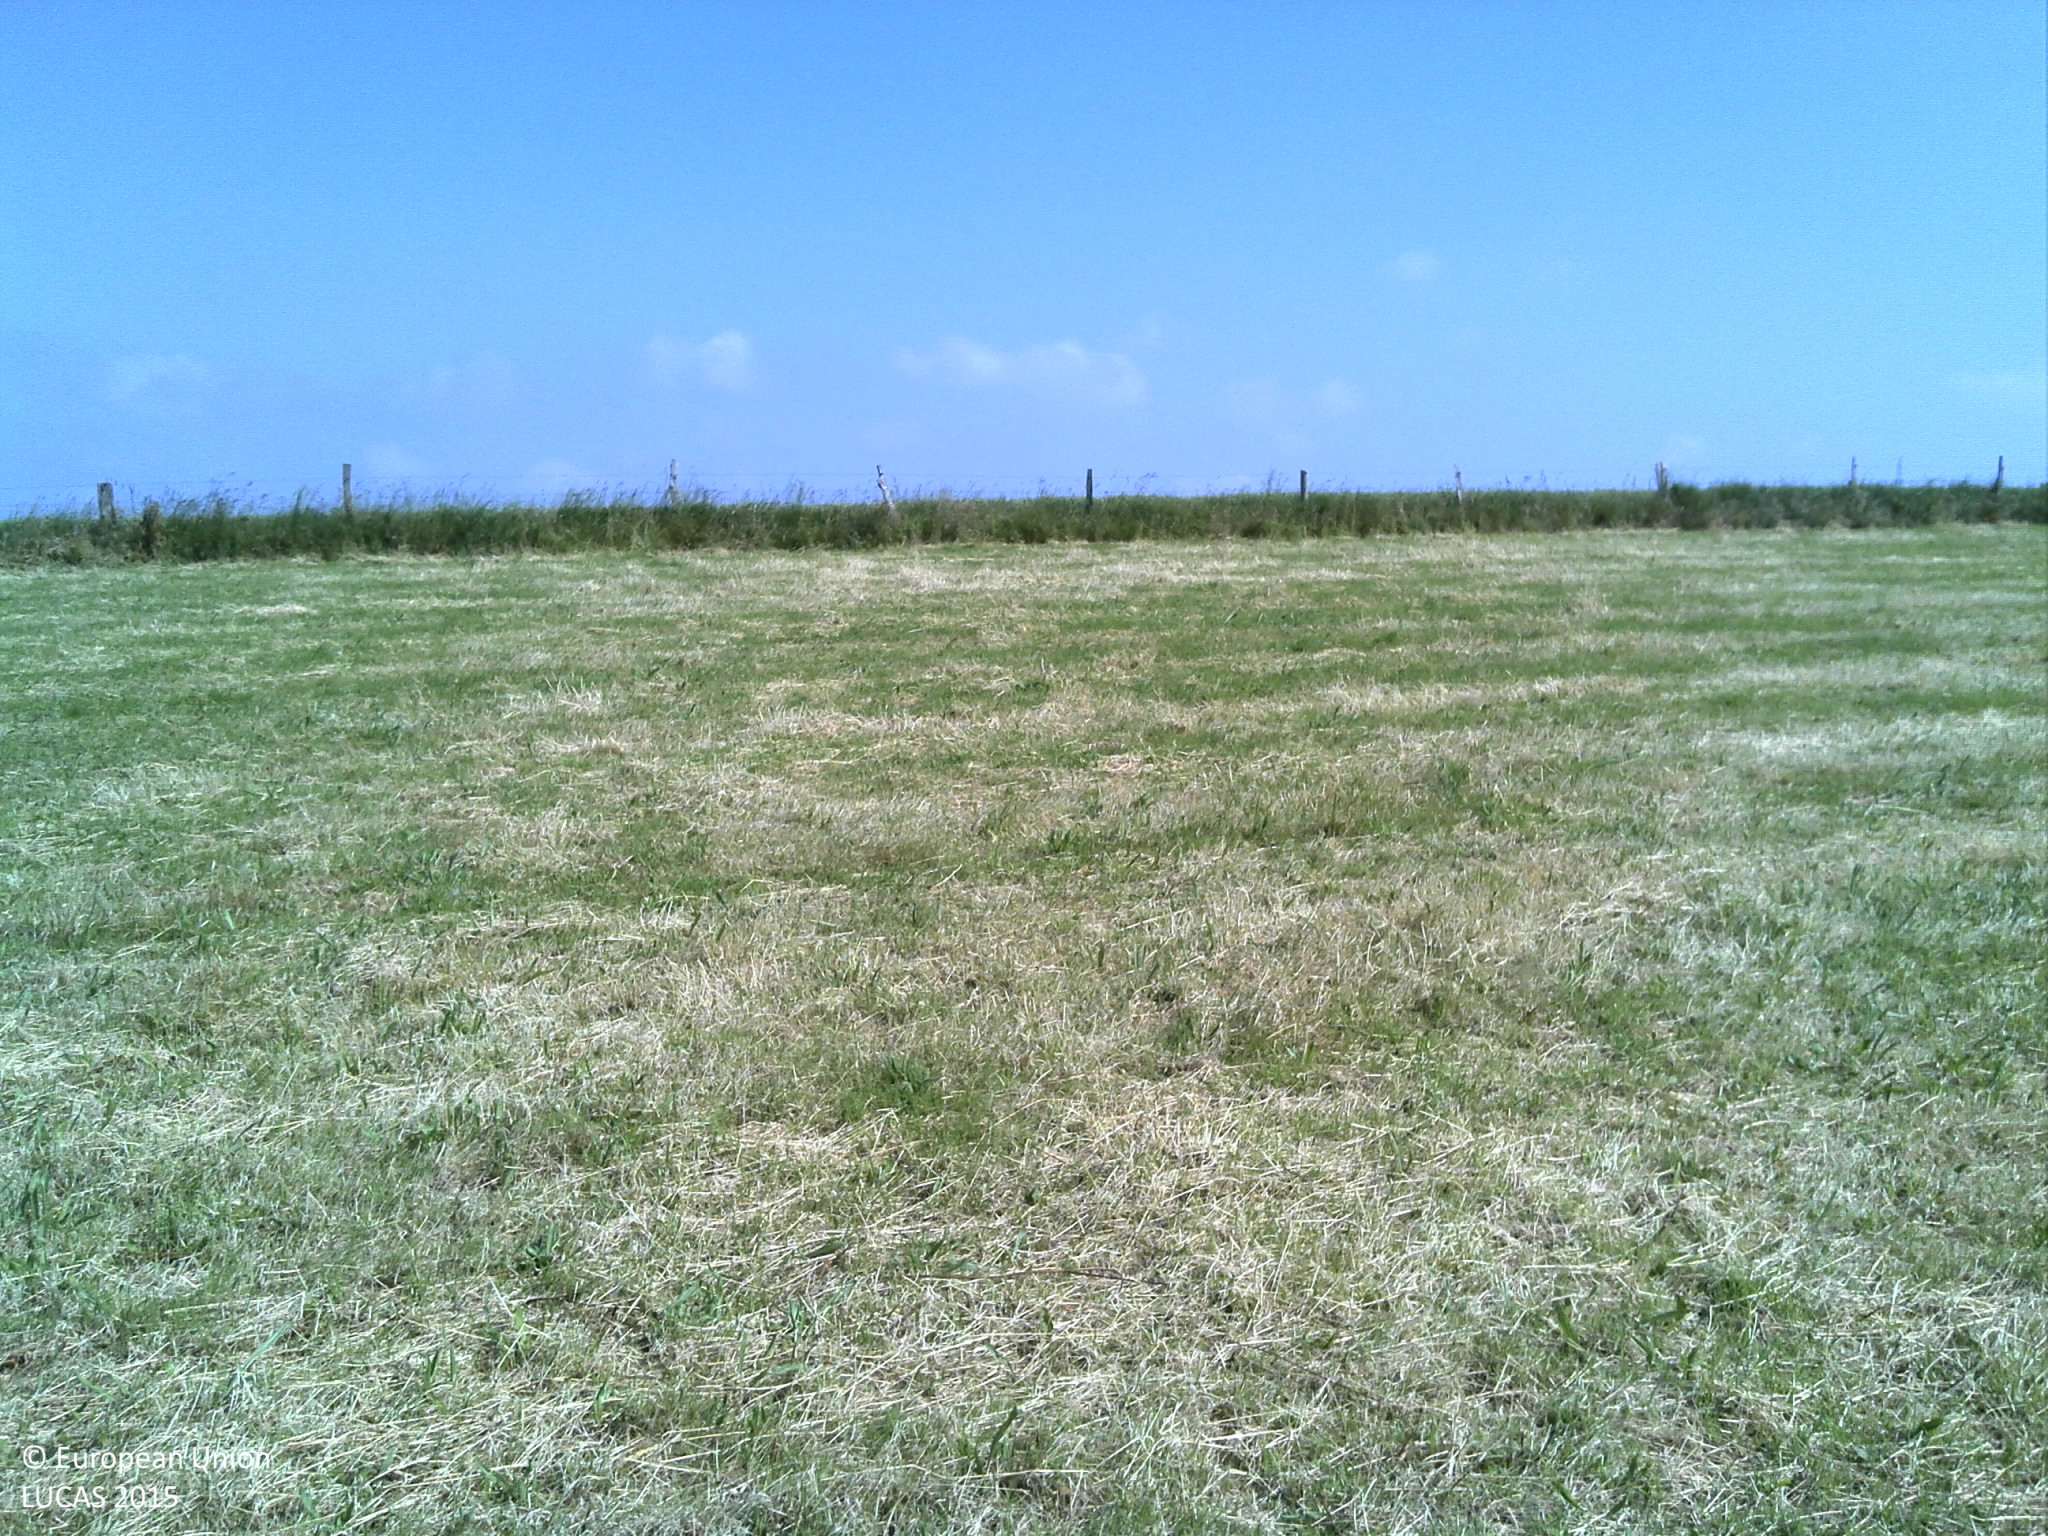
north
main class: Grassland
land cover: Grassland without tree/shrub cover
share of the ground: > 75 %
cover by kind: herbaceous plants 100 %
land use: Agriculture (excluding fallow land and kitchen gardens)
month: June
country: FR
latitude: 49.4897
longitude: 0.6285
